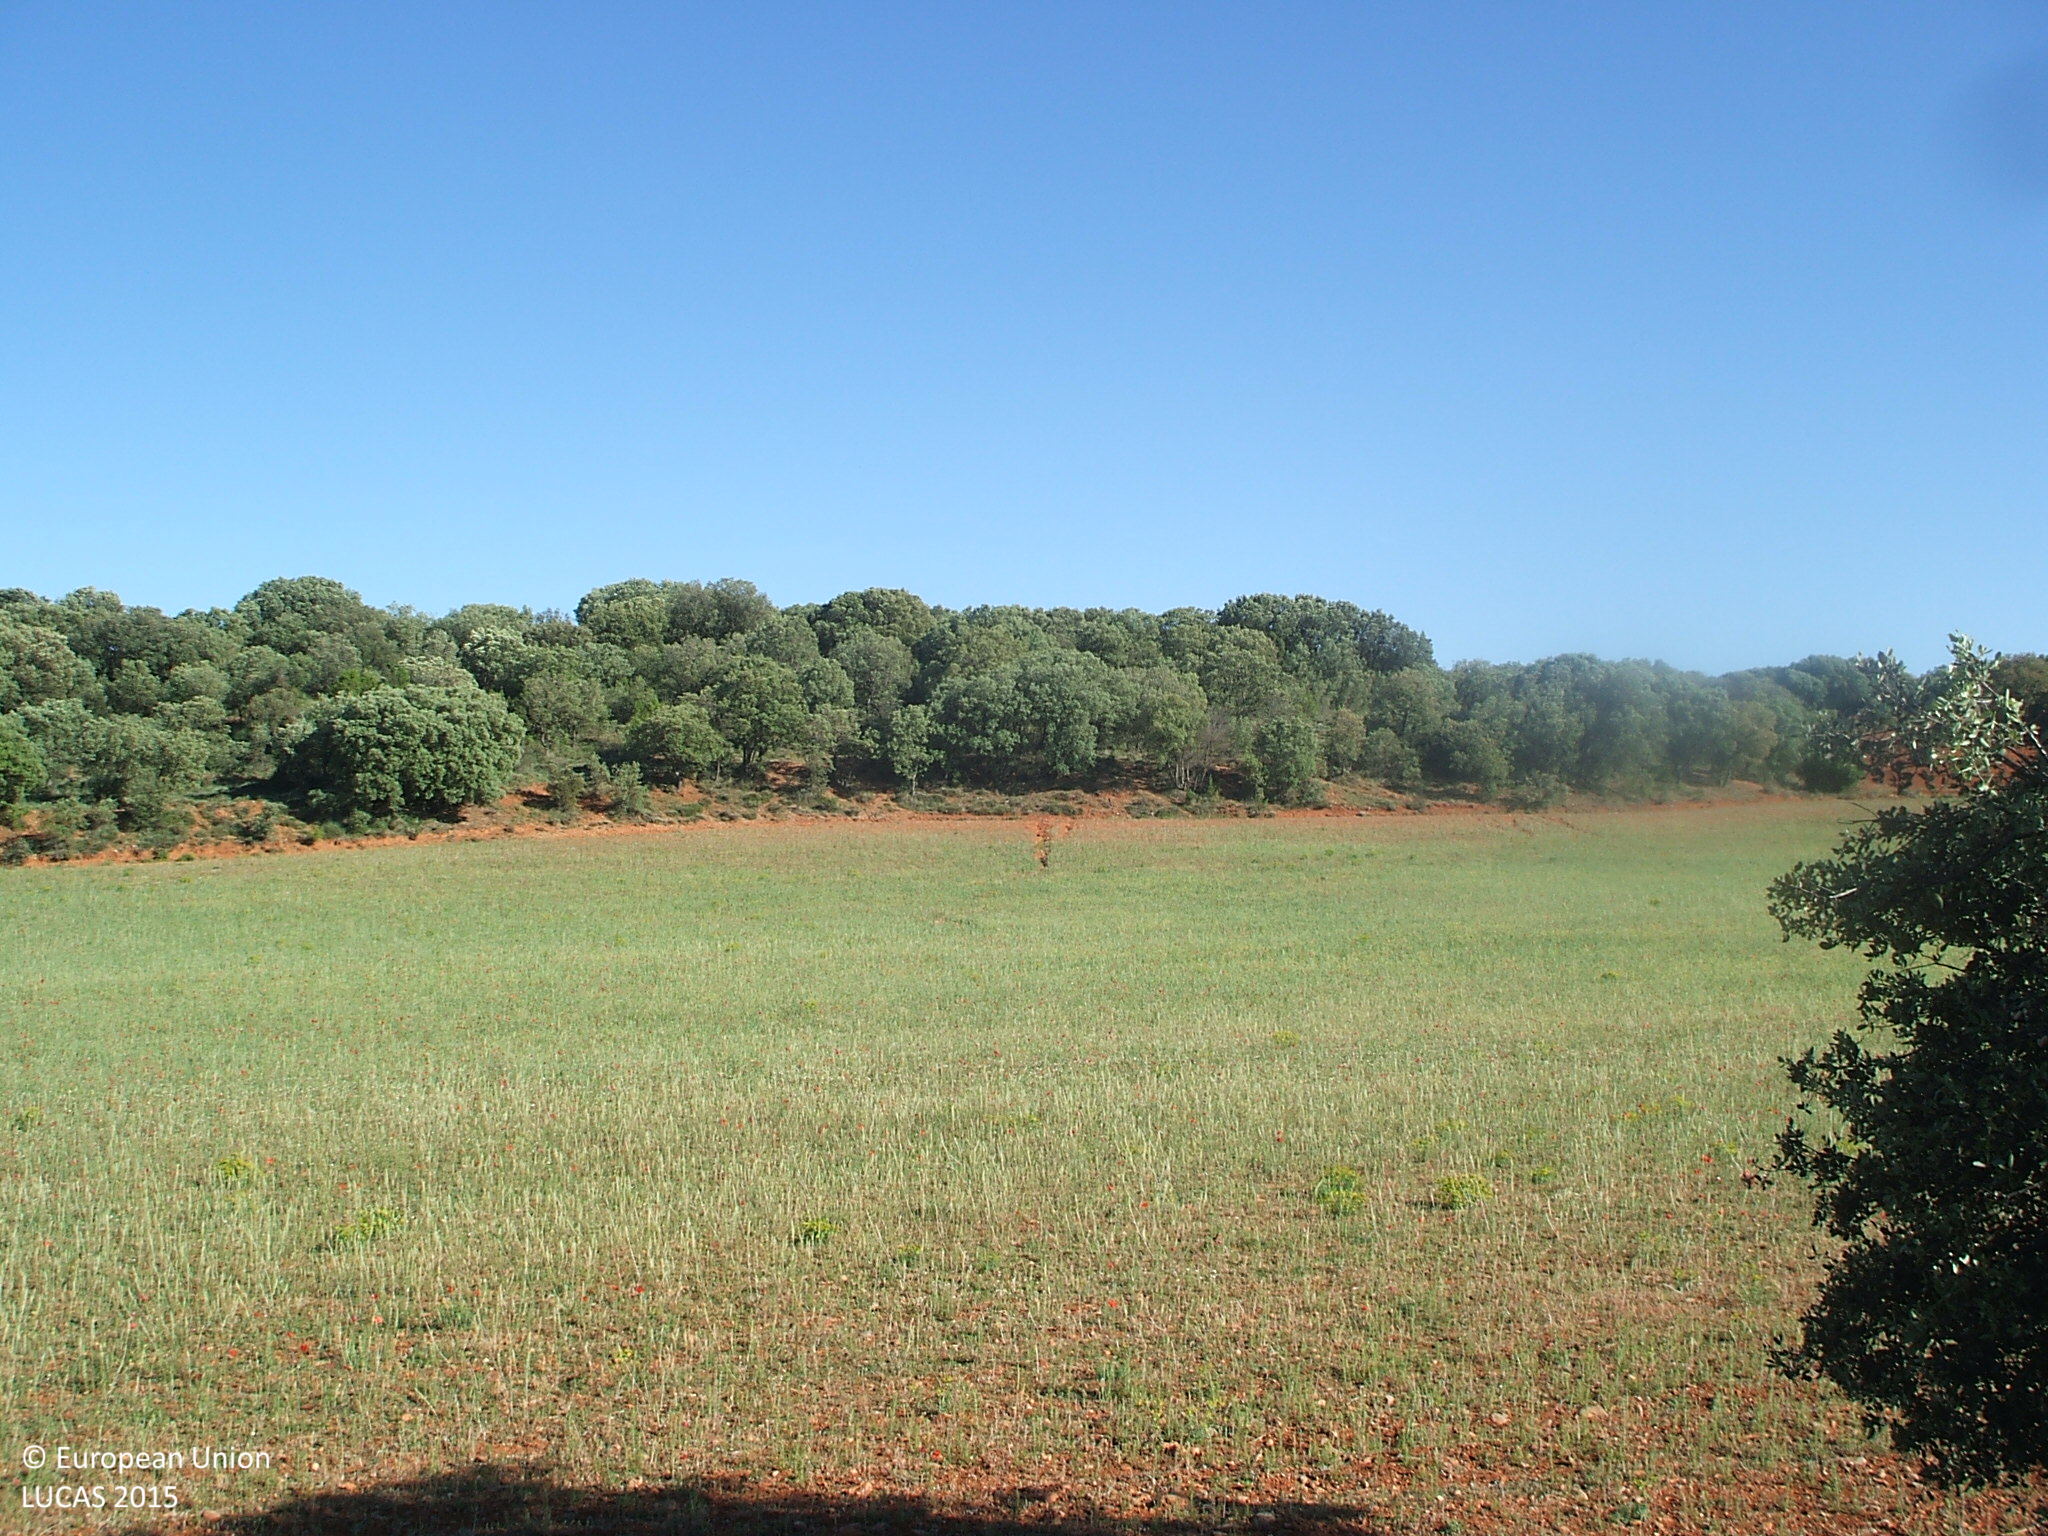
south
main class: Woodland
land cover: Broadleaved woodland
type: broadleaved evergreen forest
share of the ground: > 75 %
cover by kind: broadleaved forest trees 80 %, shrubs 20 %
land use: Semi-natural and natural areas not in use
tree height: < 5 m
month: May
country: ES
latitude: 40.0778
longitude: -0.7353
